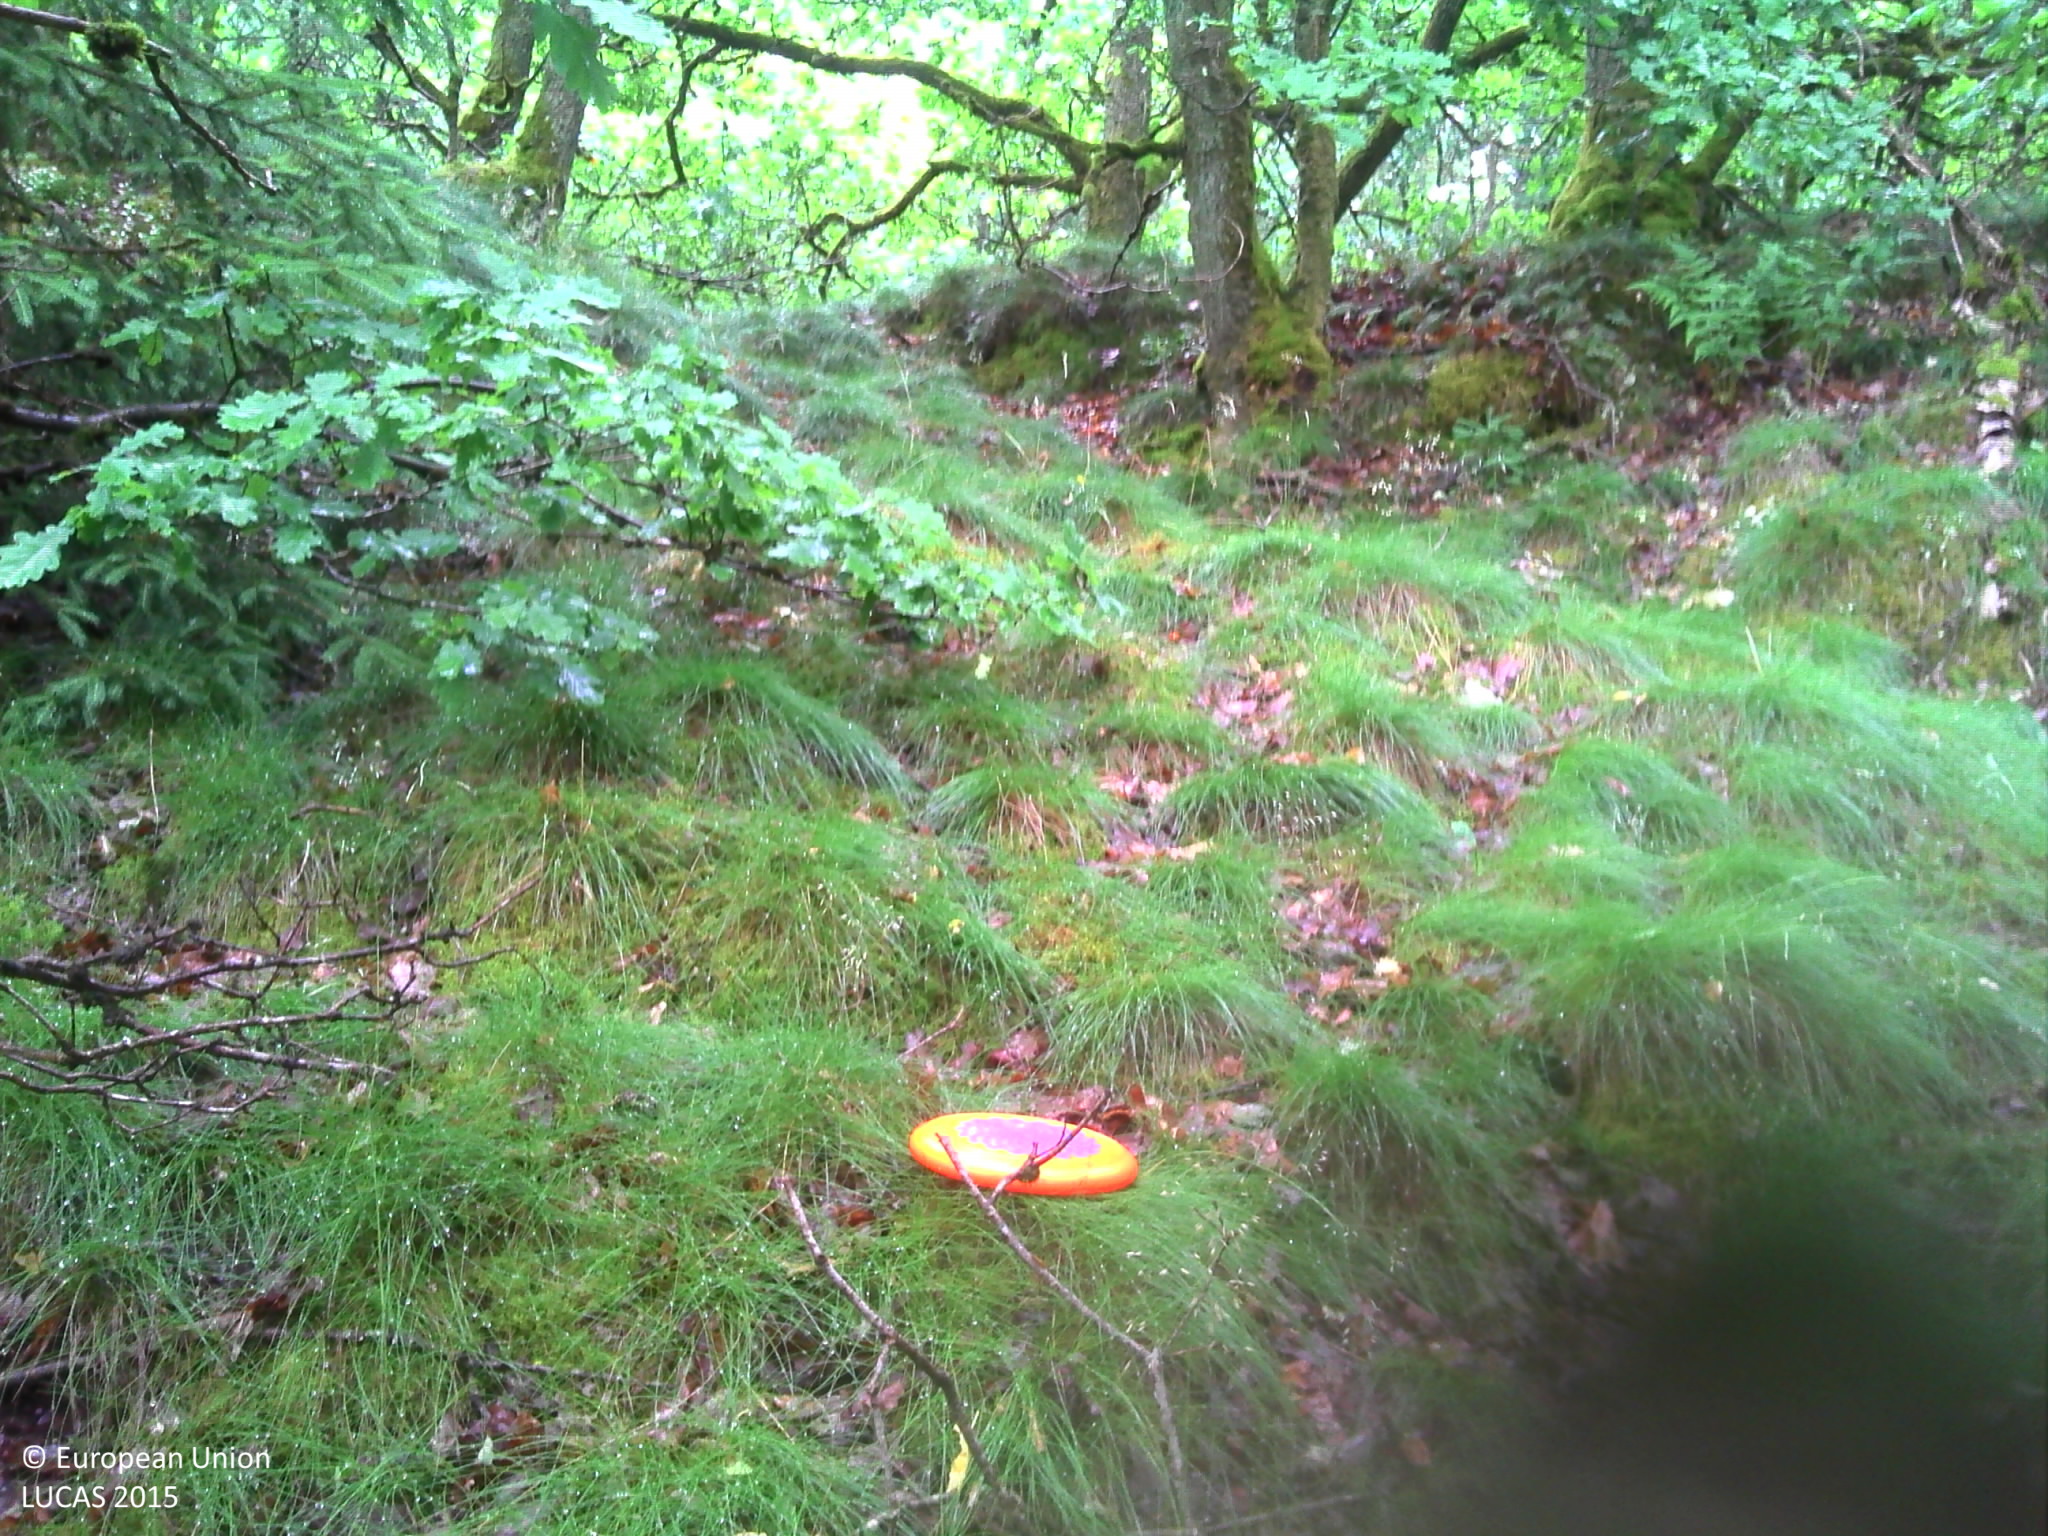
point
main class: Woodland
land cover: Broadleaved woodland
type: acidophilous oak and oak-birch forest
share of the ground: > 75 %
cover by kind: broadleaved forest trees 95 %, herbaceous plants 5 %
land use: Forestry
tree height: > 5 m
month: June
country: BE
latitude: 50.1867
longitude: 5.5305
